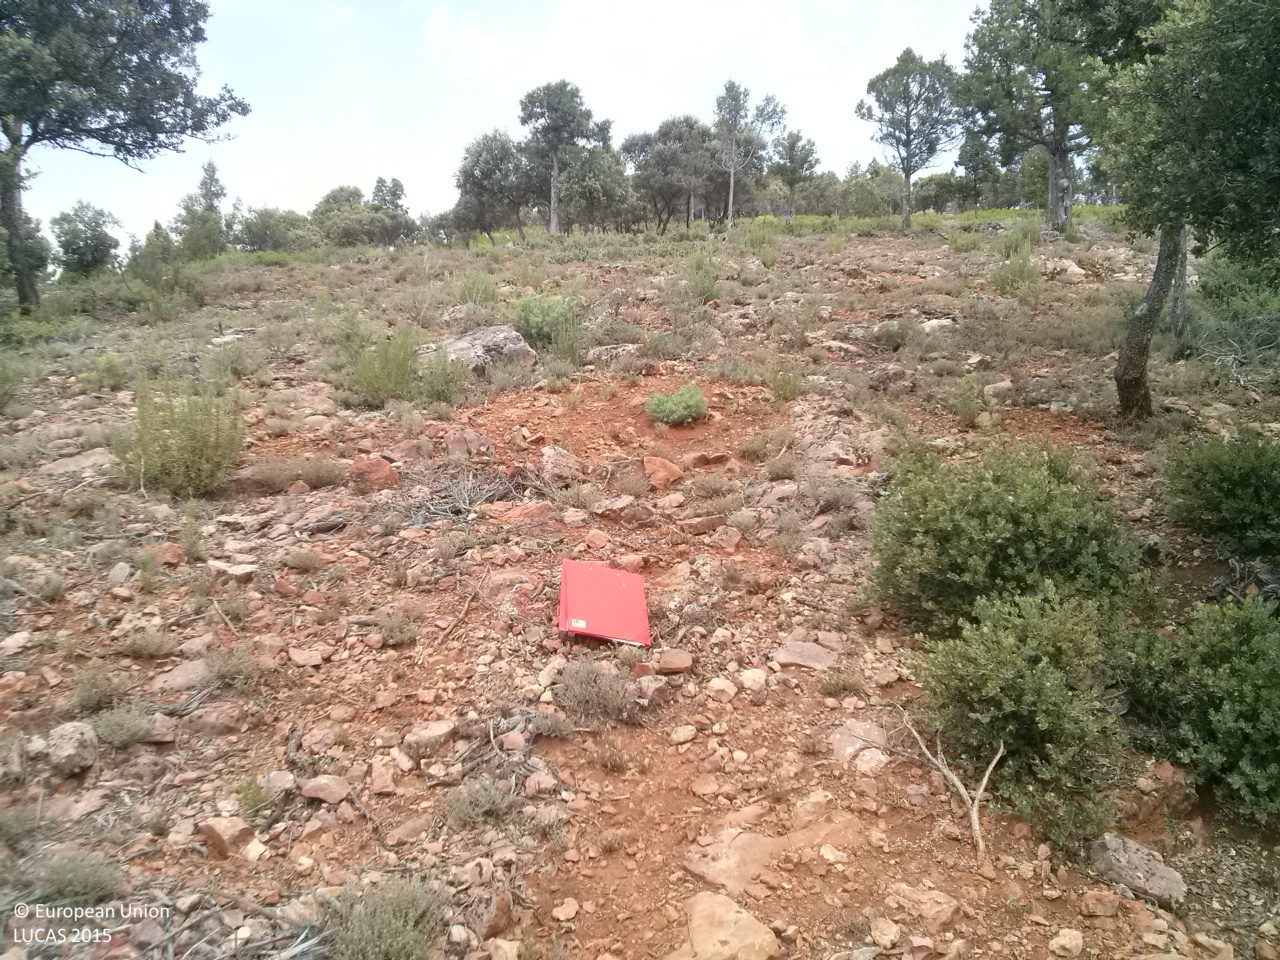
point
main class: Woodland
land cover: Other mixed woodland
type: broadleaved evergreen forest
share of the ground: 25 - 50 %
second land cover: Grassland without tree/shrub cover
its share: 25 - 50 %
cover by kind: herbaceous plants 30 %, broadleaved forest trees 20 %, shrubs 20 %, unconsolidated bare surface 20 %, coniferous forest trees 10 %
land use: Forestry
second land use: Agriculture (excluding fallow land and kitchen gardens)
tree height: < 5 m
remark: Clear cut
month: June
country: ES
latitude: 39.9931
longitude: -1.7825
